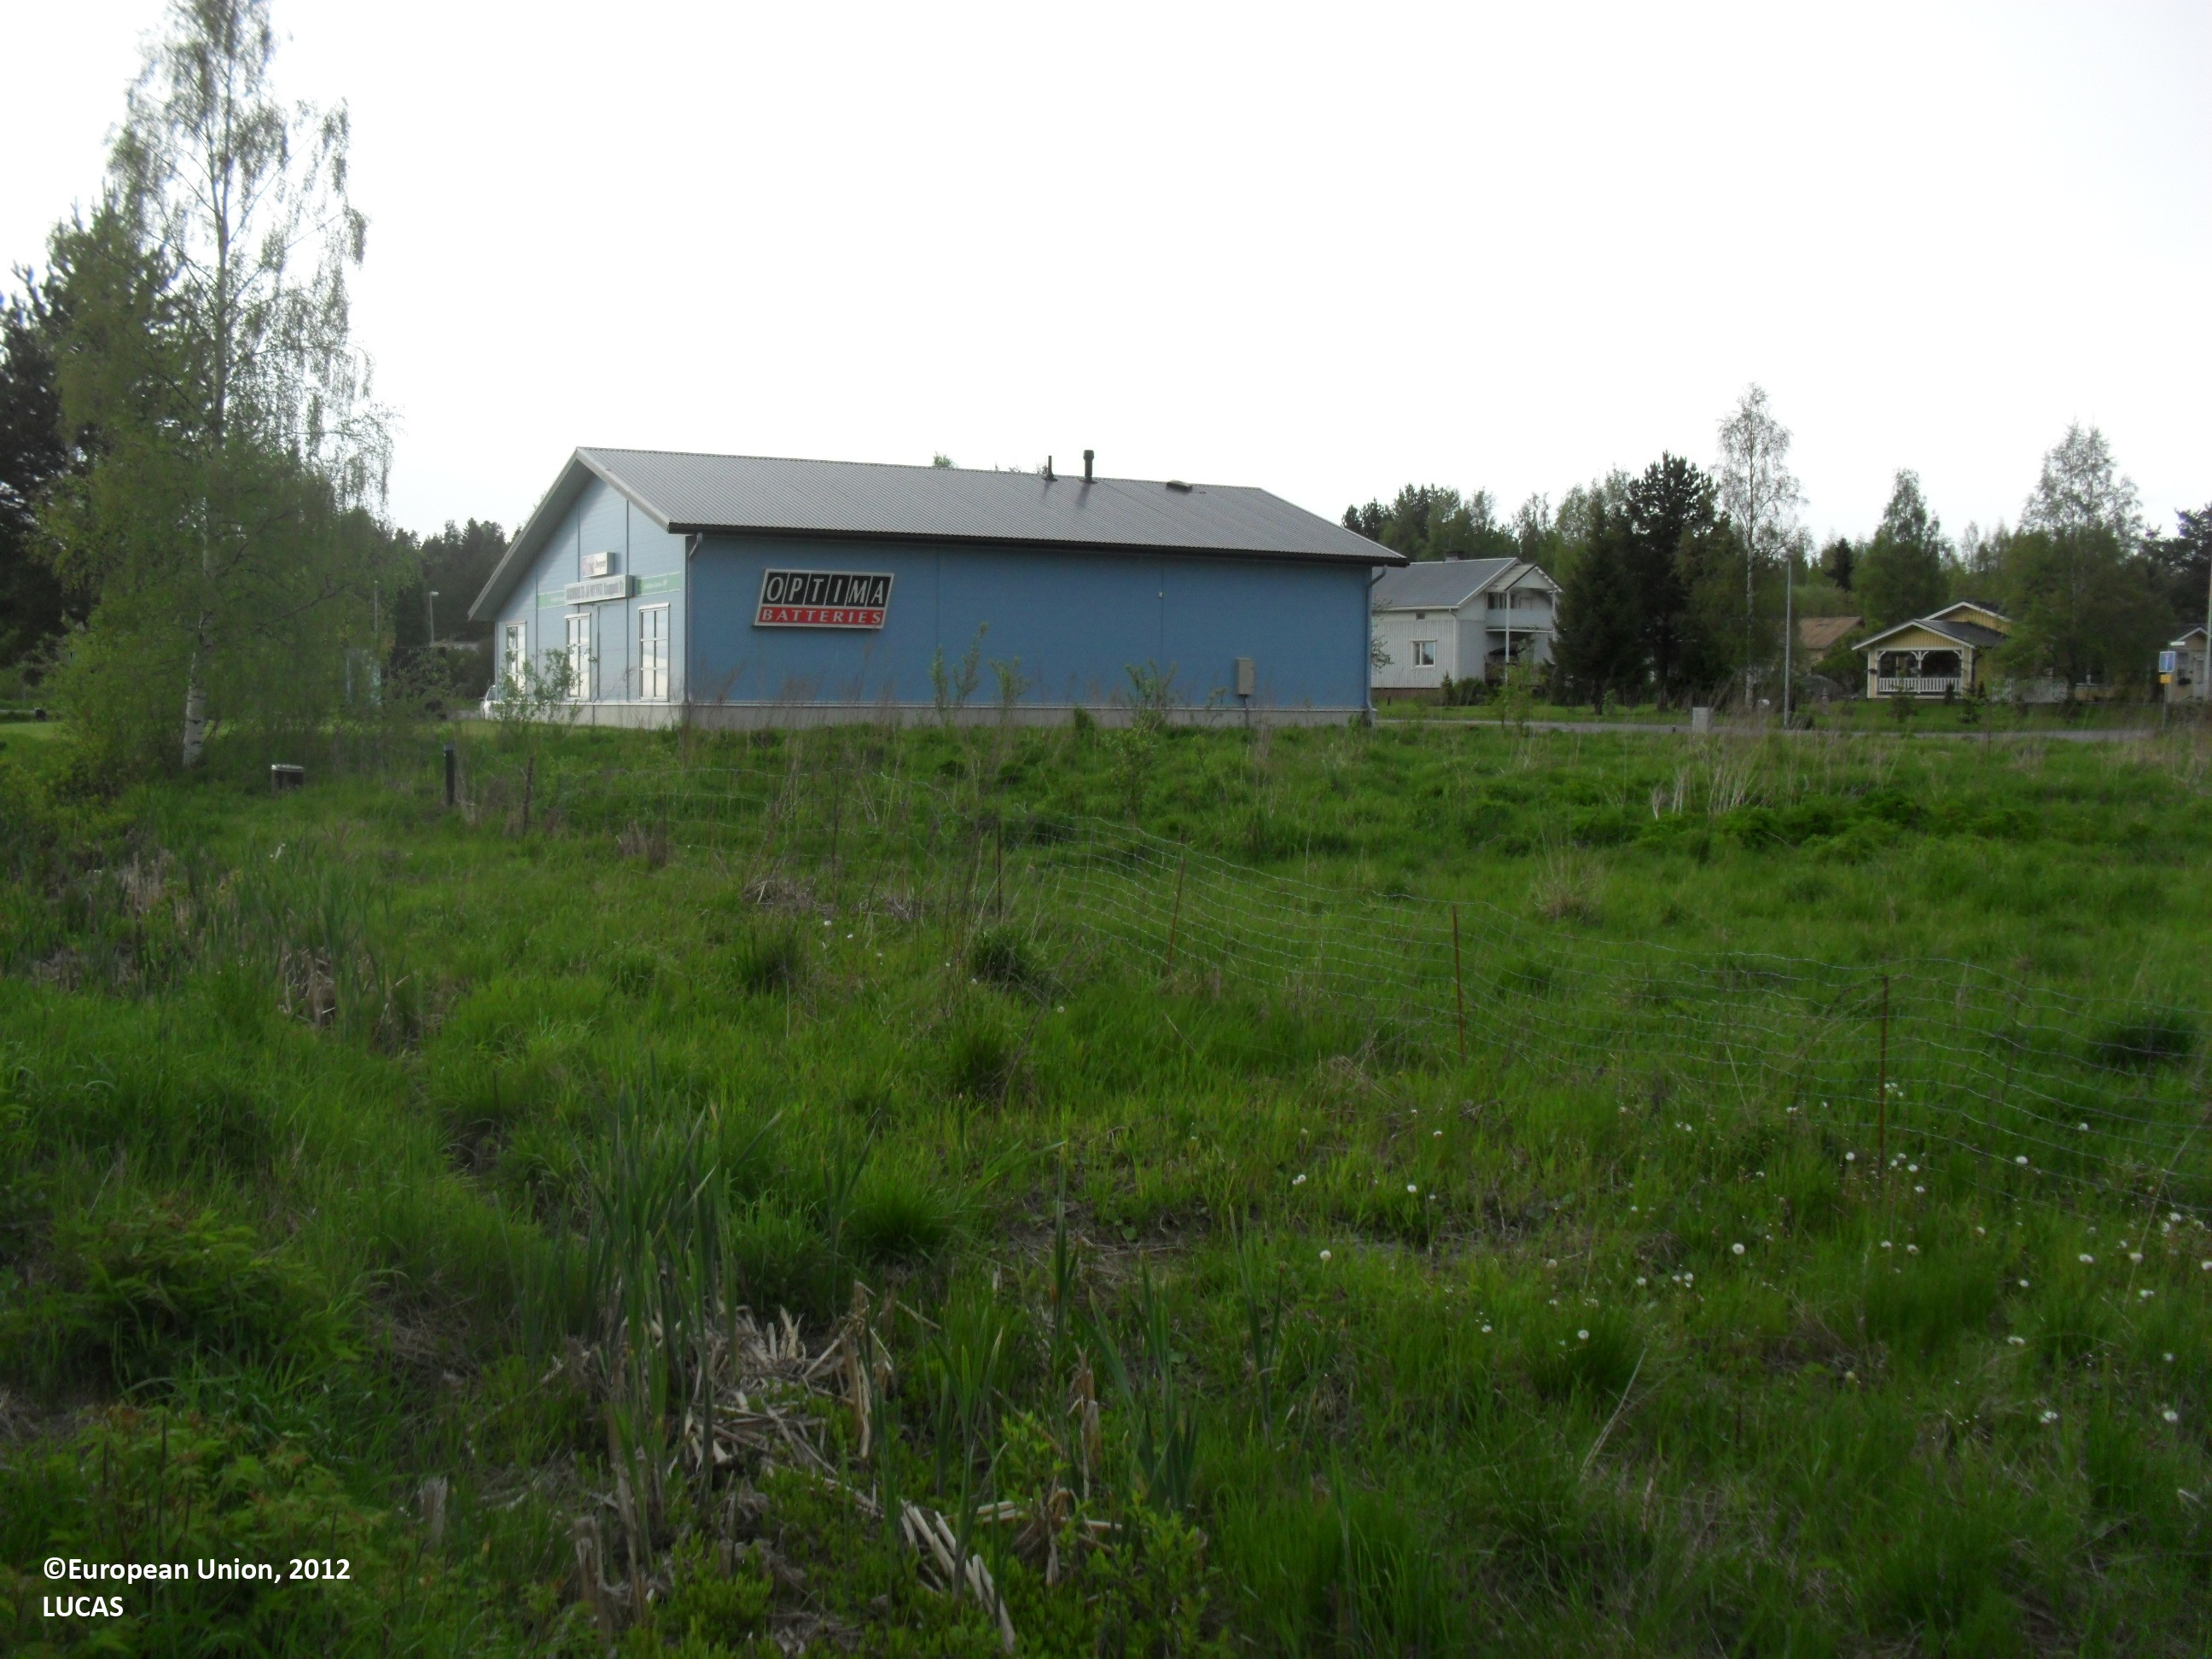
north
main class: Grassland
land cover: Grassland without tree/shrub cover
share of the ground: > 75 %
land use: Semi-natural and natural areas not in use
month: June
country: FI
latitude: 62.9785
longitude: 23.0213
